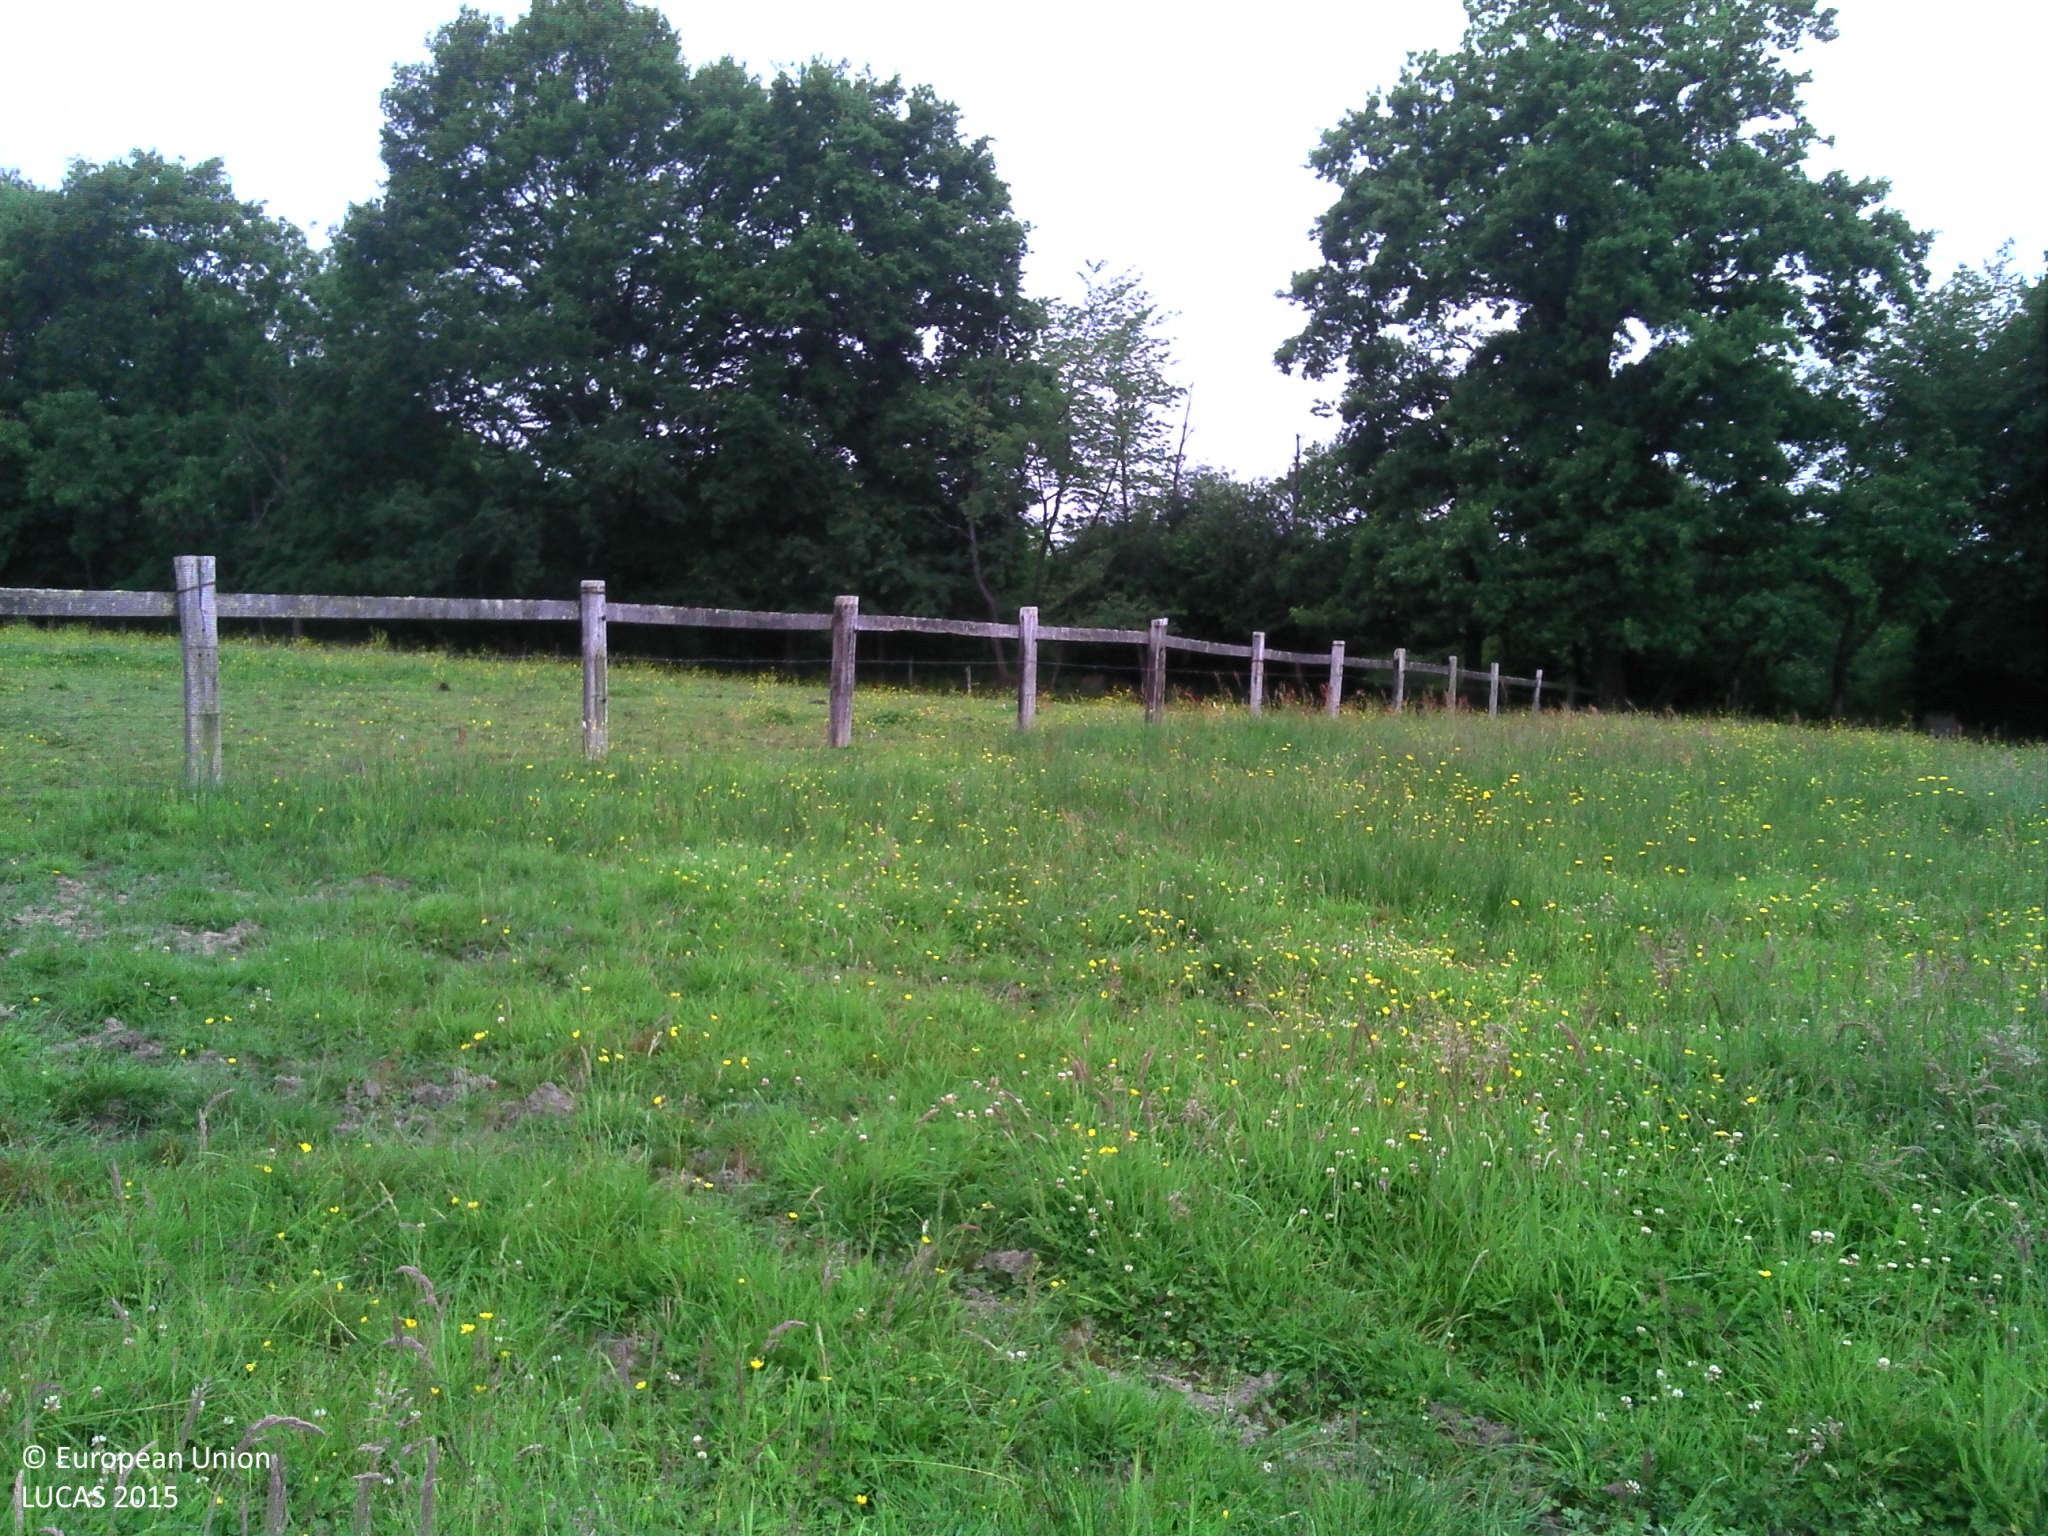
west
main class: Grassland
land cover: Grassland without tree/shrub cover
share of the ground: > 75 %
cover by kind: herbaceous plants 100 %
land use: Agriculture (excluding fallow land and kitchen gardens)
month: June
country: FR
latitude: 49.2347
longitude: -0.0157
